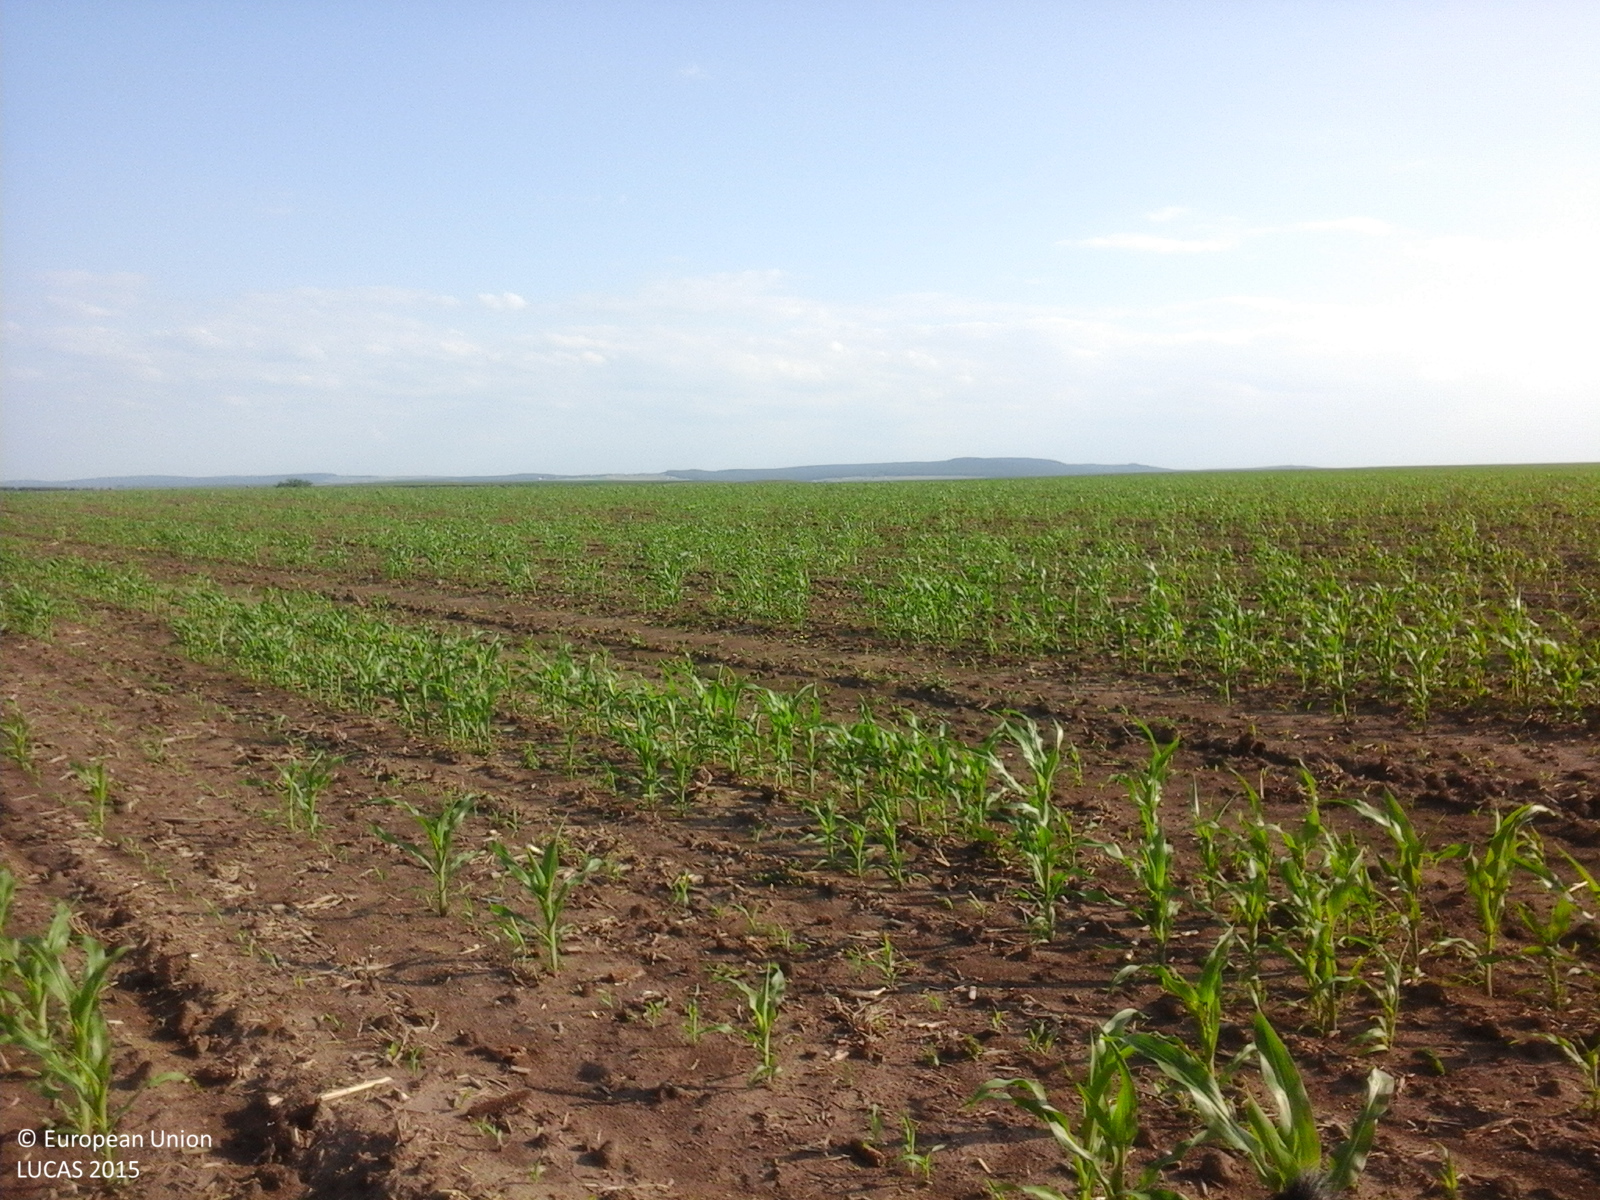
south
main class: Cropland
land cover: Maize
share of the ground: 10 - 25 %
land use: Agriculture (excluding fallow land and kitchen gardens)
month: June
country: RO
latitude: 47.8654
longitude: 26.5210
